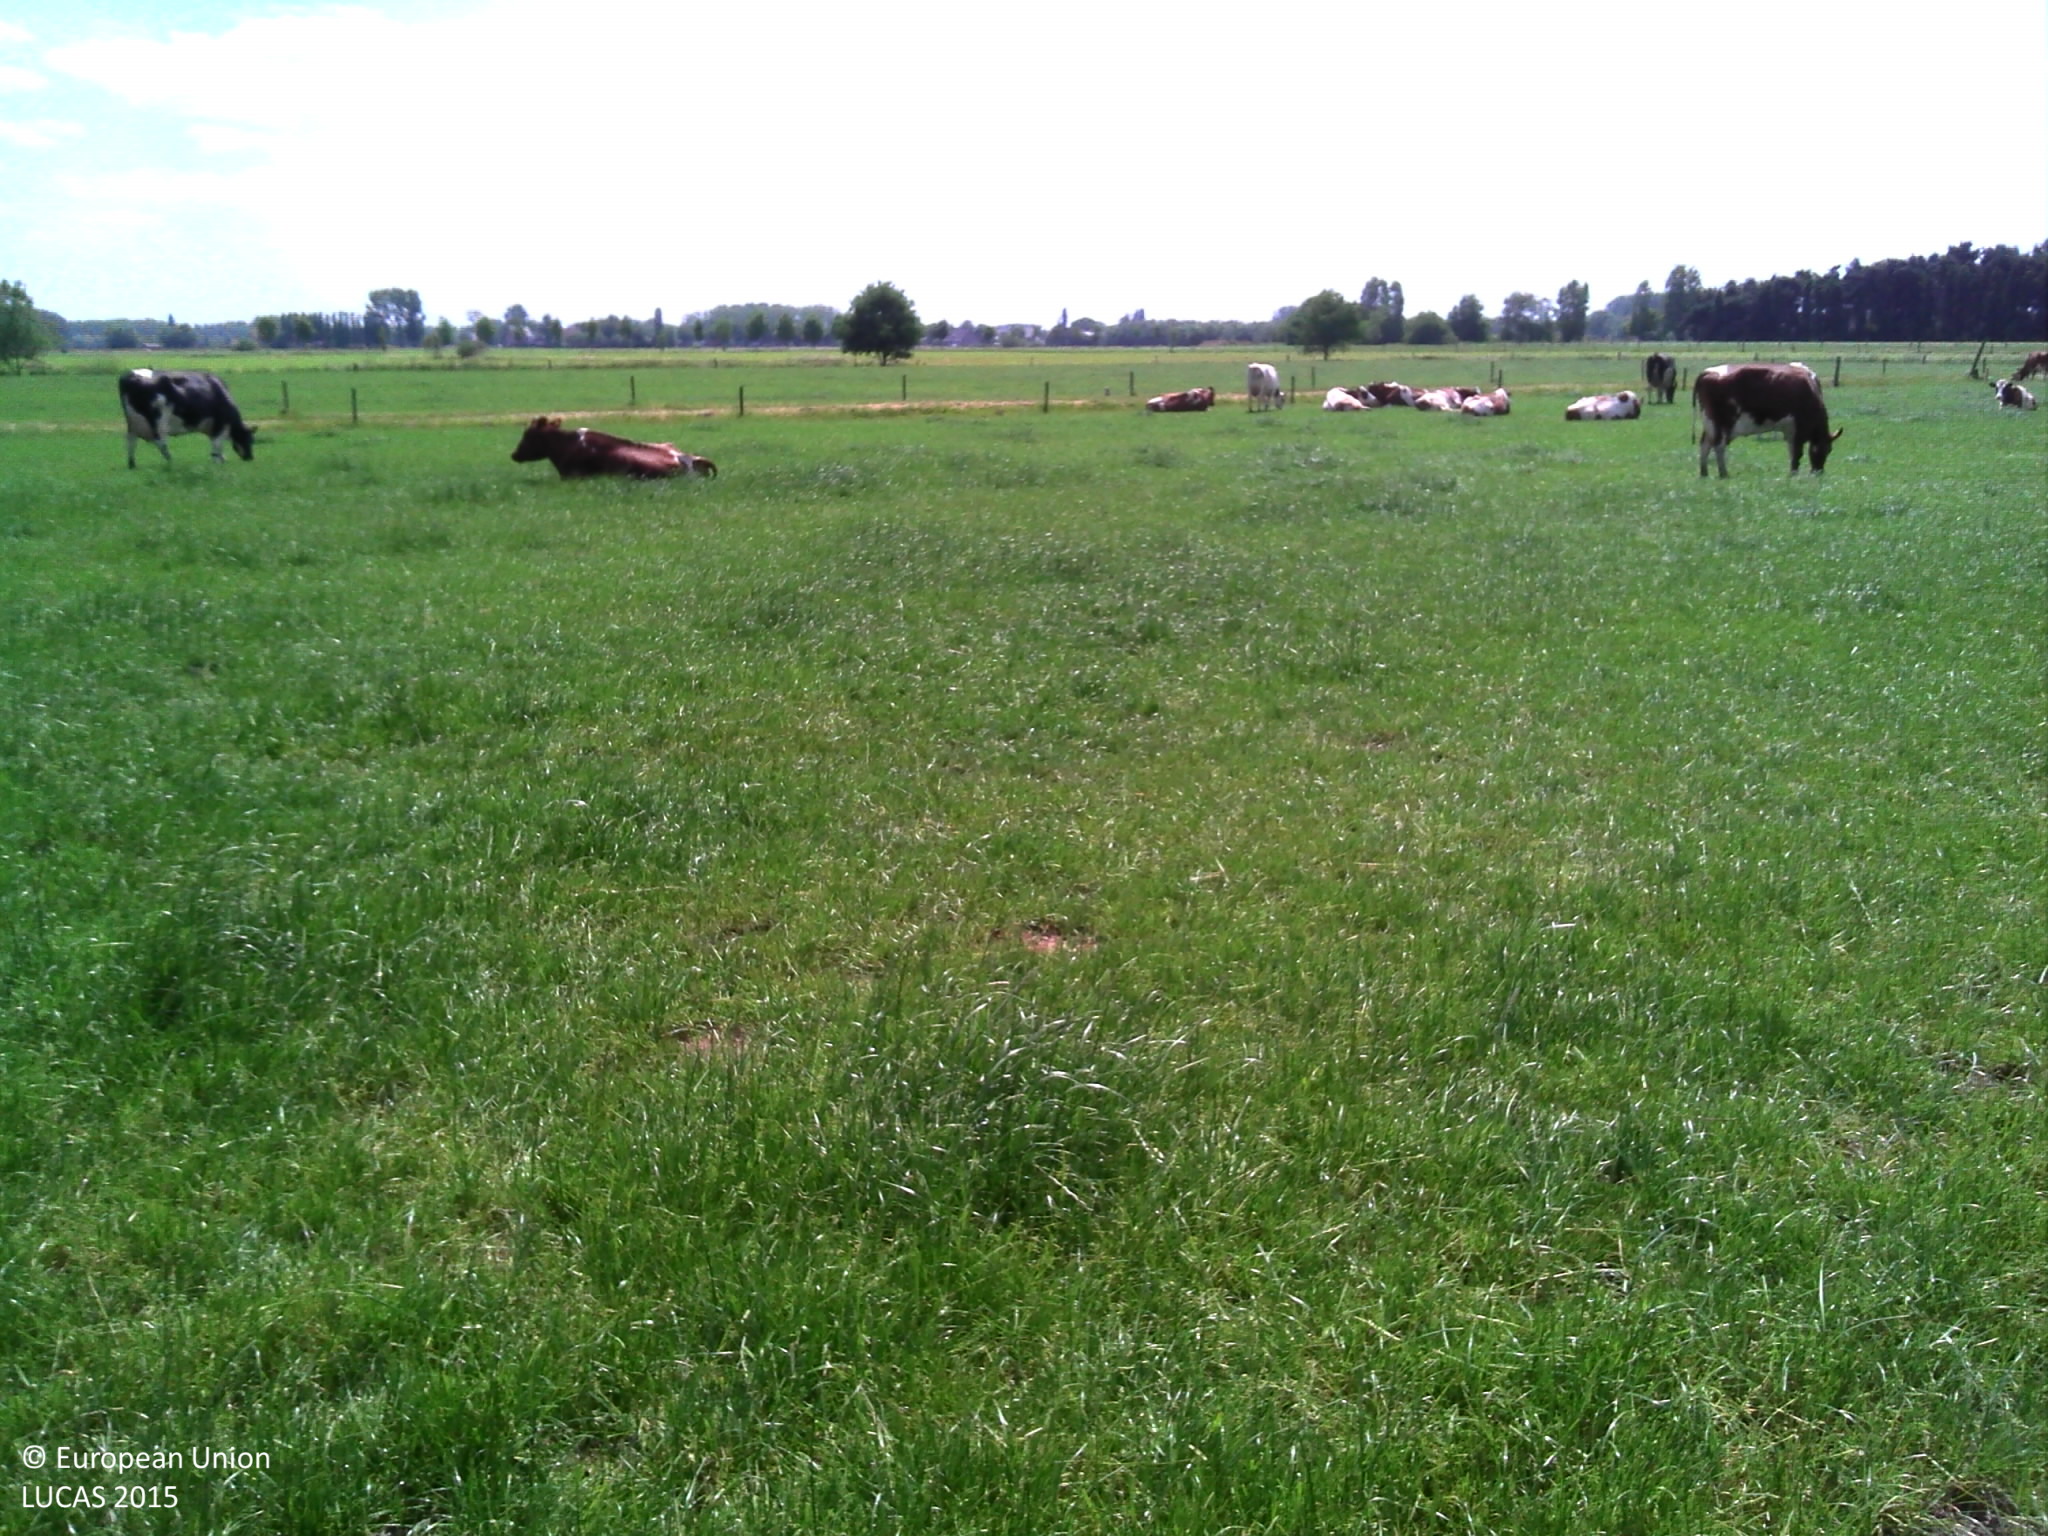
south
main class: Grassland
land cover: Grassland without tree/shrub cover
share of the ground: > 75 %
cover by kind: herbaceous plants 100 %
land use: Agriculture (excluding fallow land and kitchen gardens)
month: June
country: BE
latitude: 51.0369
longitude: 4.0188
